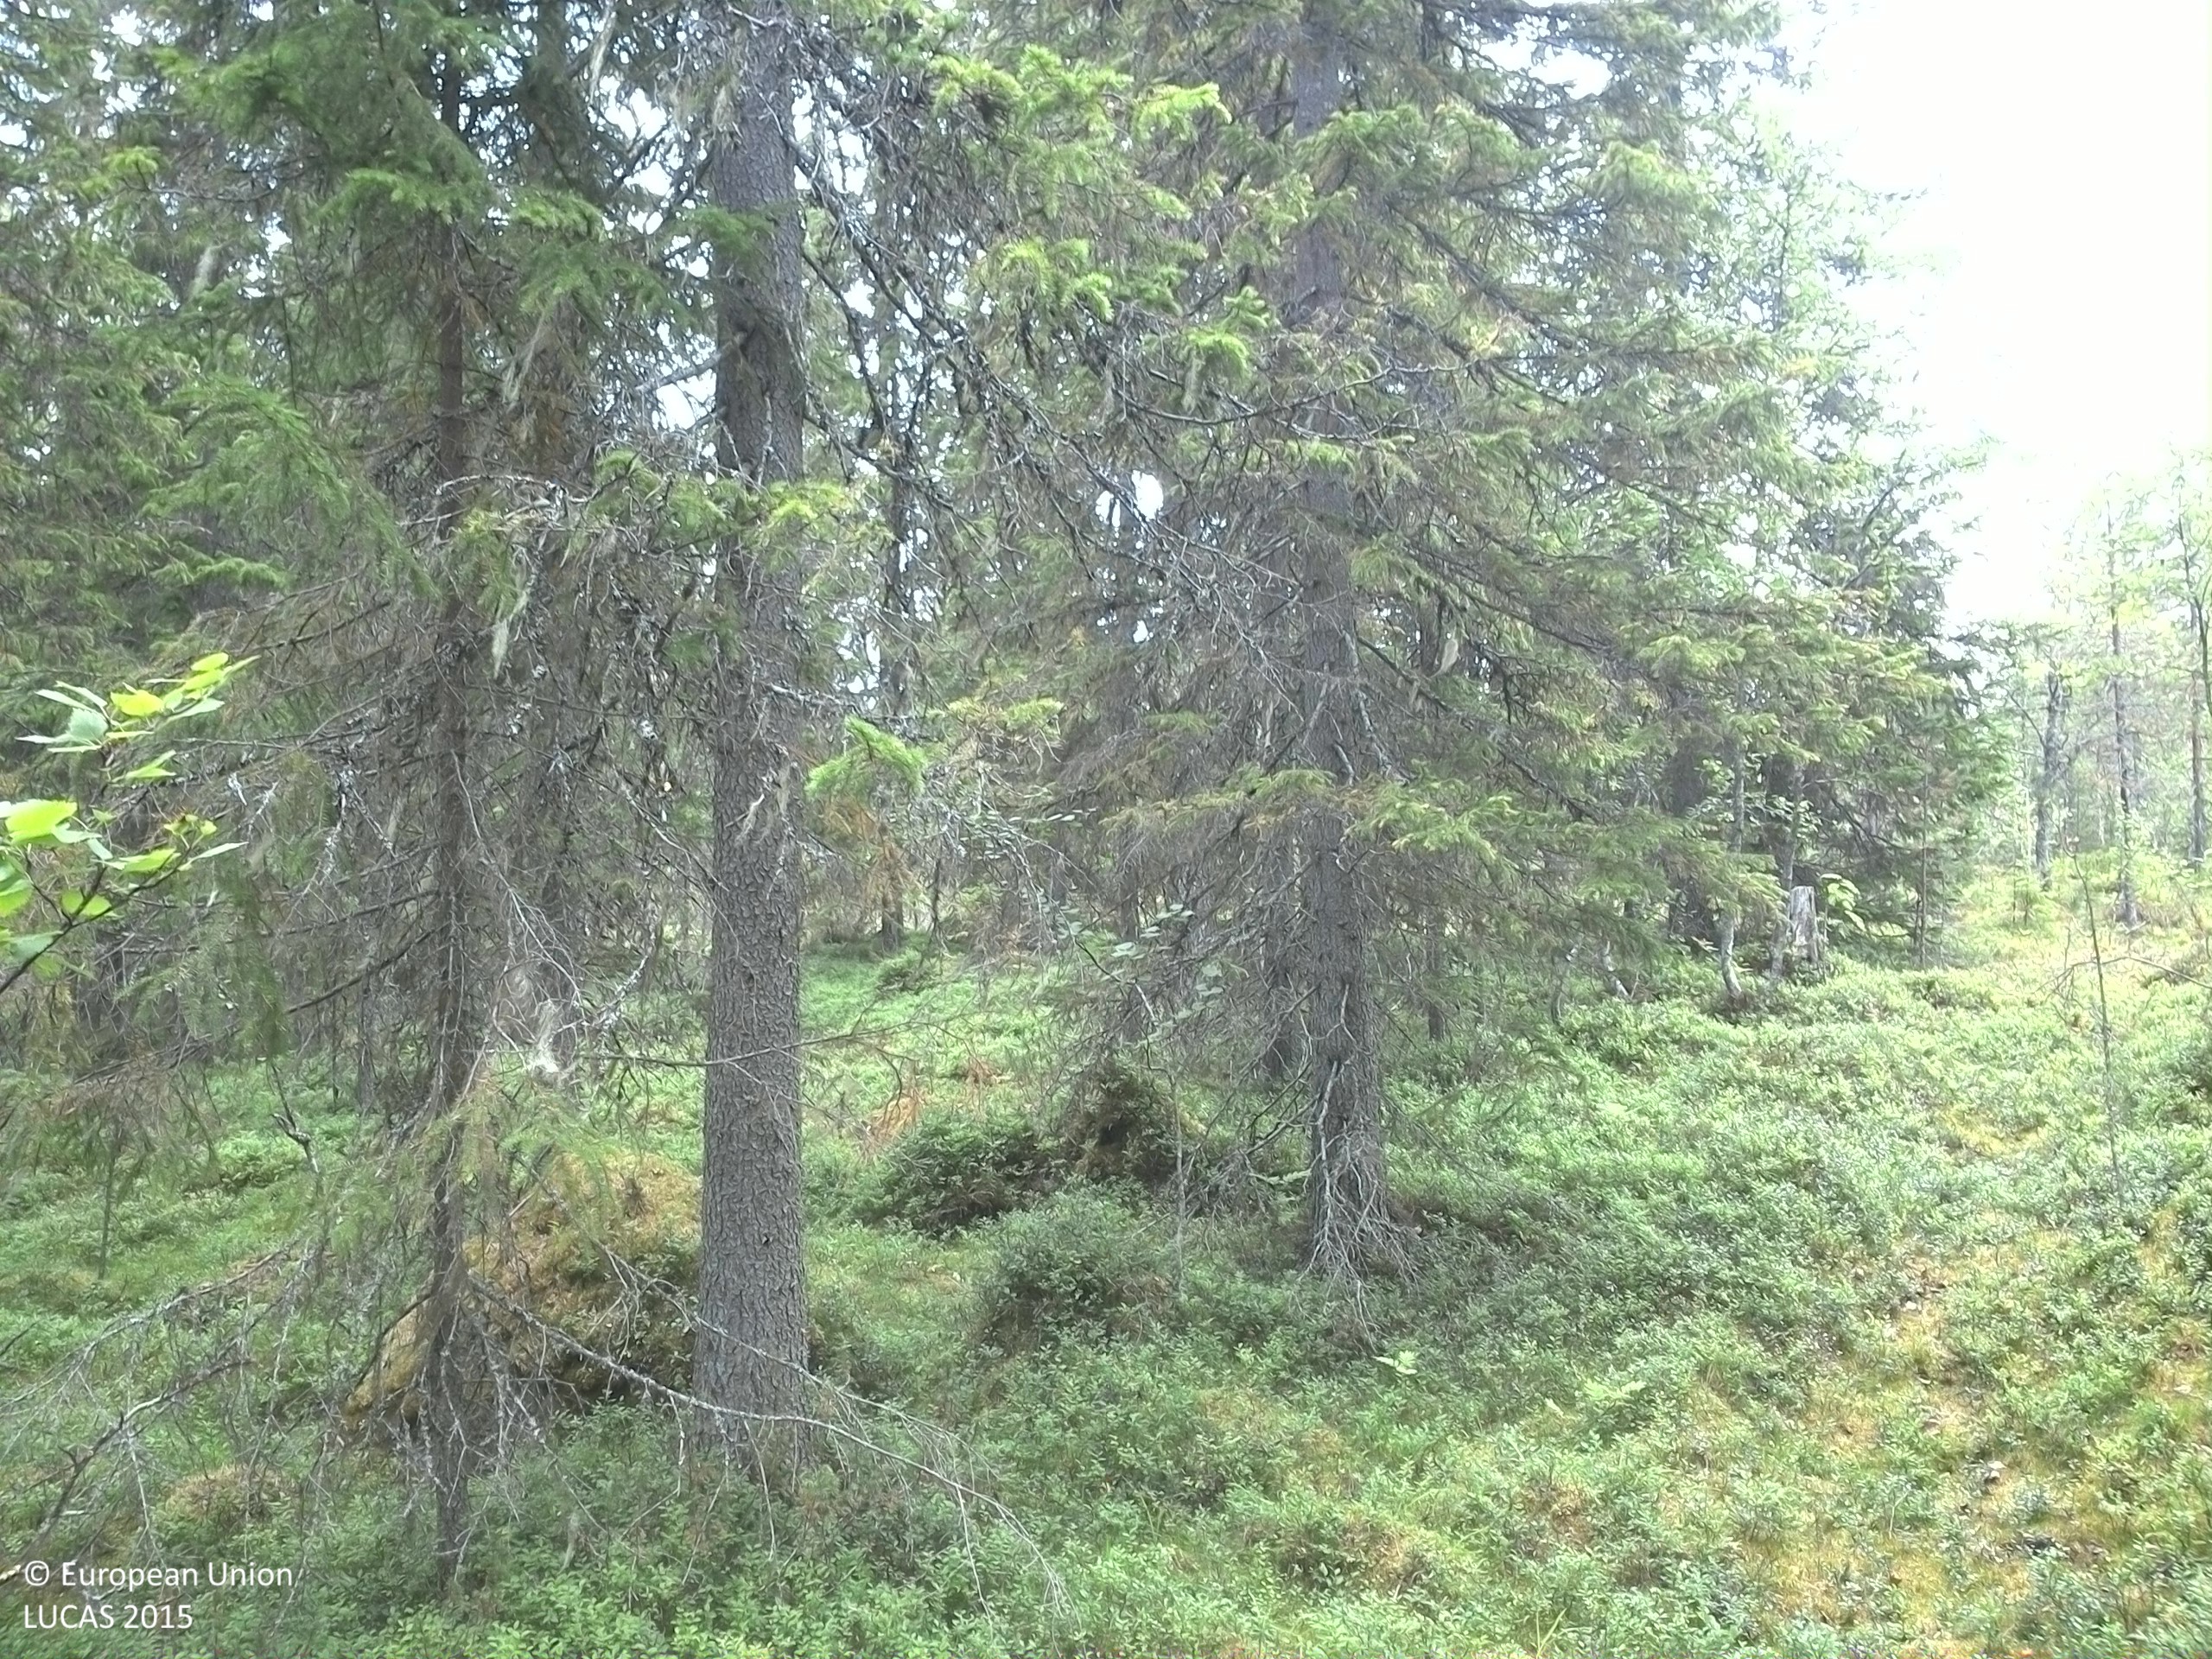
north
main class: Woodland
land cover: Spruce dominated coniferous woodland
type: boreal forest
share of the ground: > 75 %
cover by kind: coniferous forest trees 75 %, shrubs 20 %, lichens and mosses 5 %
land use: Forestry
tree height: > 5 m
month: August
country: SE
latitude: 63.7929
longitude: 17.3393
